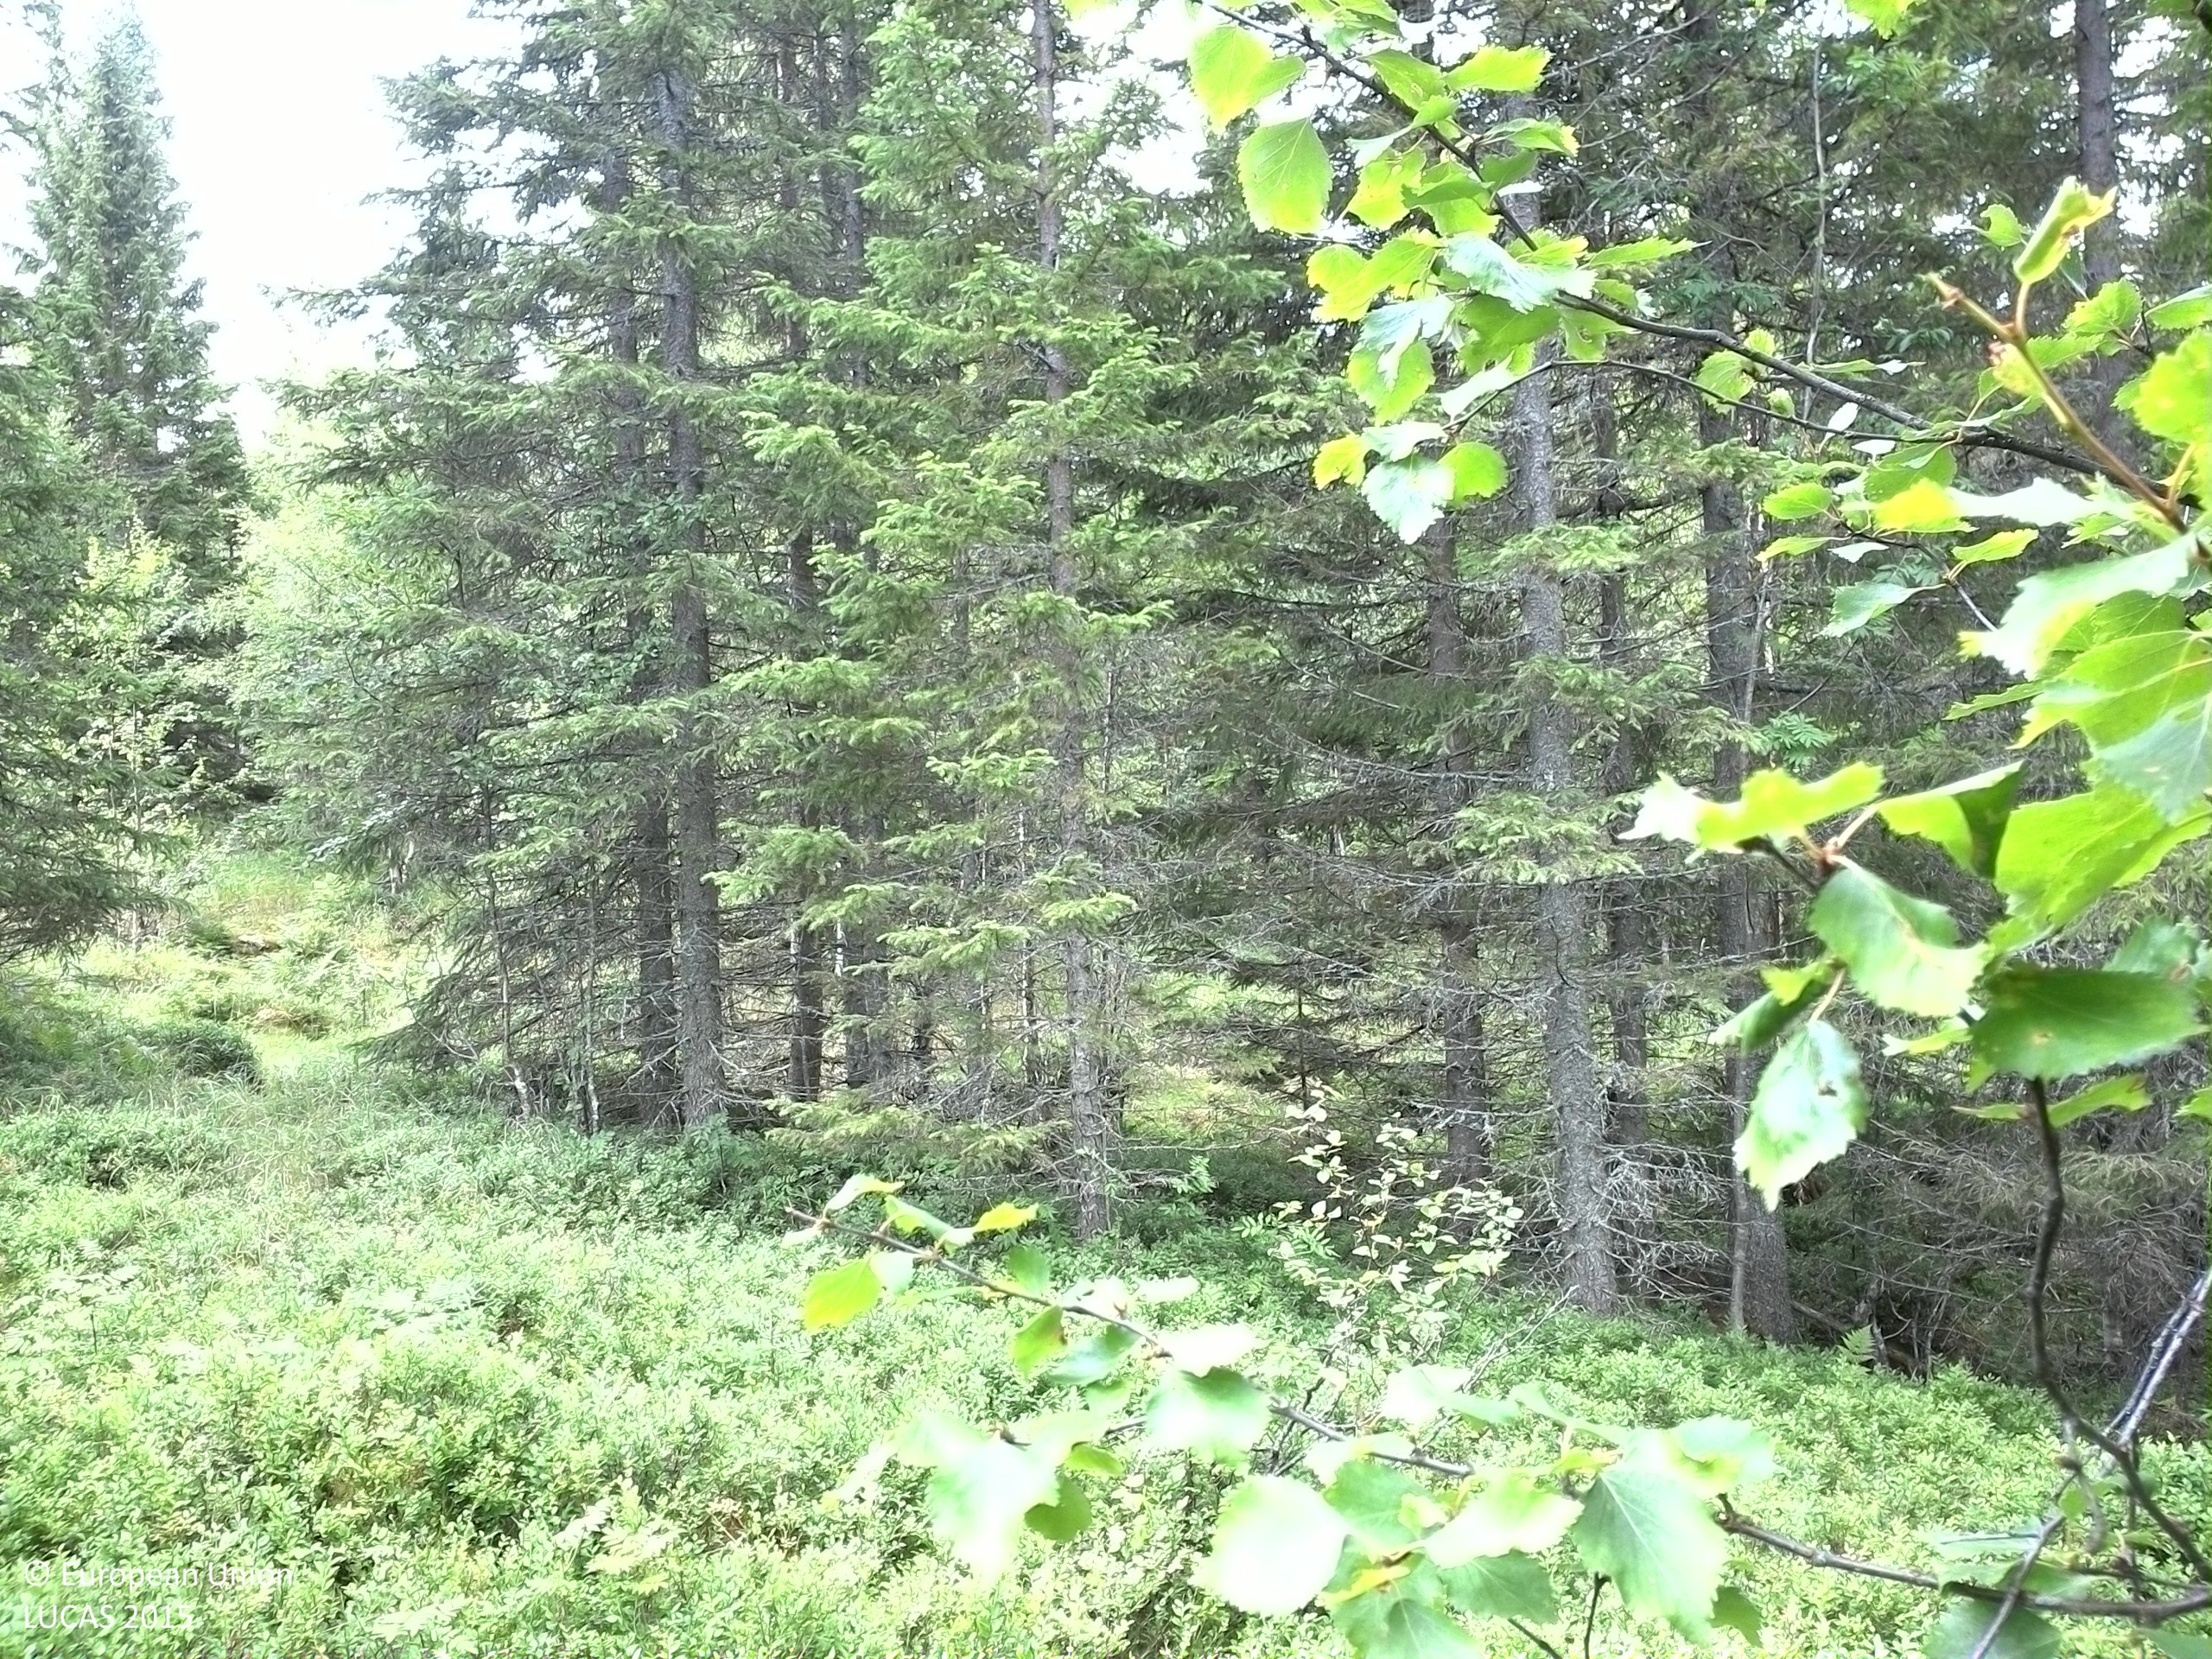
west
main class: Woodland
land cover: Spruce dominated coniferous woodland
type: boreal forest
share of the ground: 50 - 75 %
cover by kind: coniferous forest trees 55 %, shrubs 35 %, broadleaved forest trees 10 %
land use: Forestry
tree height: > 5 m
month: August
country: SE
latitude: 63.6466
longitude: 18.4349
